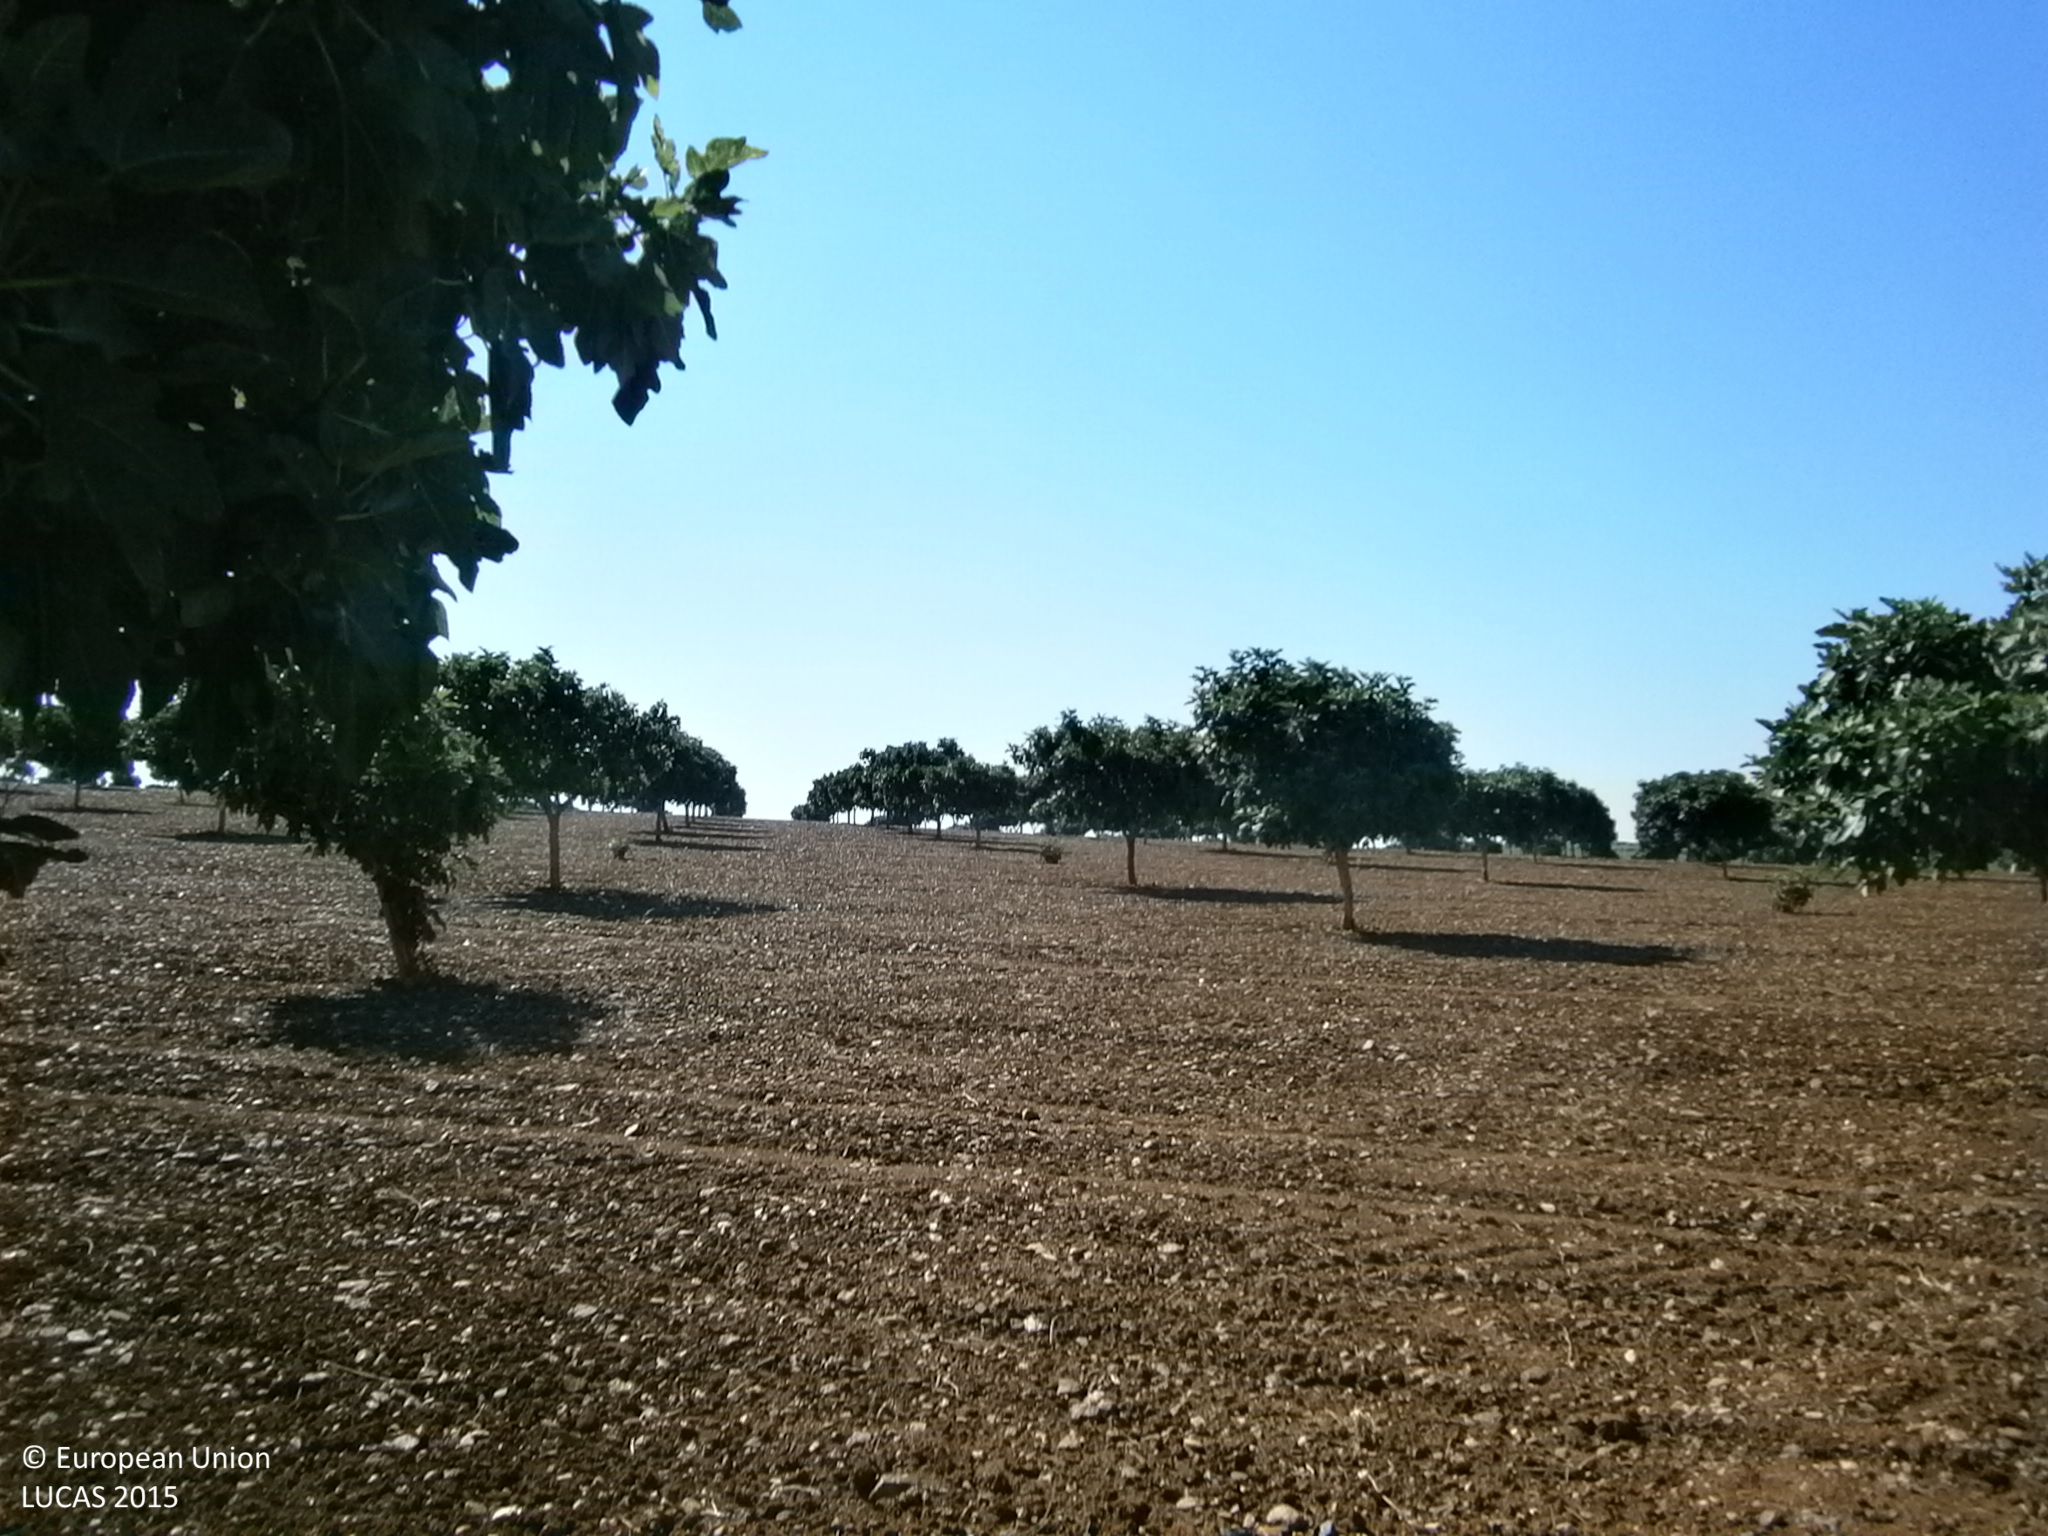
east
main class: Cropland
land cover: Other fruit trees and berries
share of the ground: 10 - 25 %
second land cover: Other bare soil
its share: > 75 %
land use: Agriculture (excluding fallow land and kitchen gardens)
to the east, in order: Other fruit trees and berries; Other bare soil
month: June
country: ES
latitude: 38.6724
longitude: -6.6215
